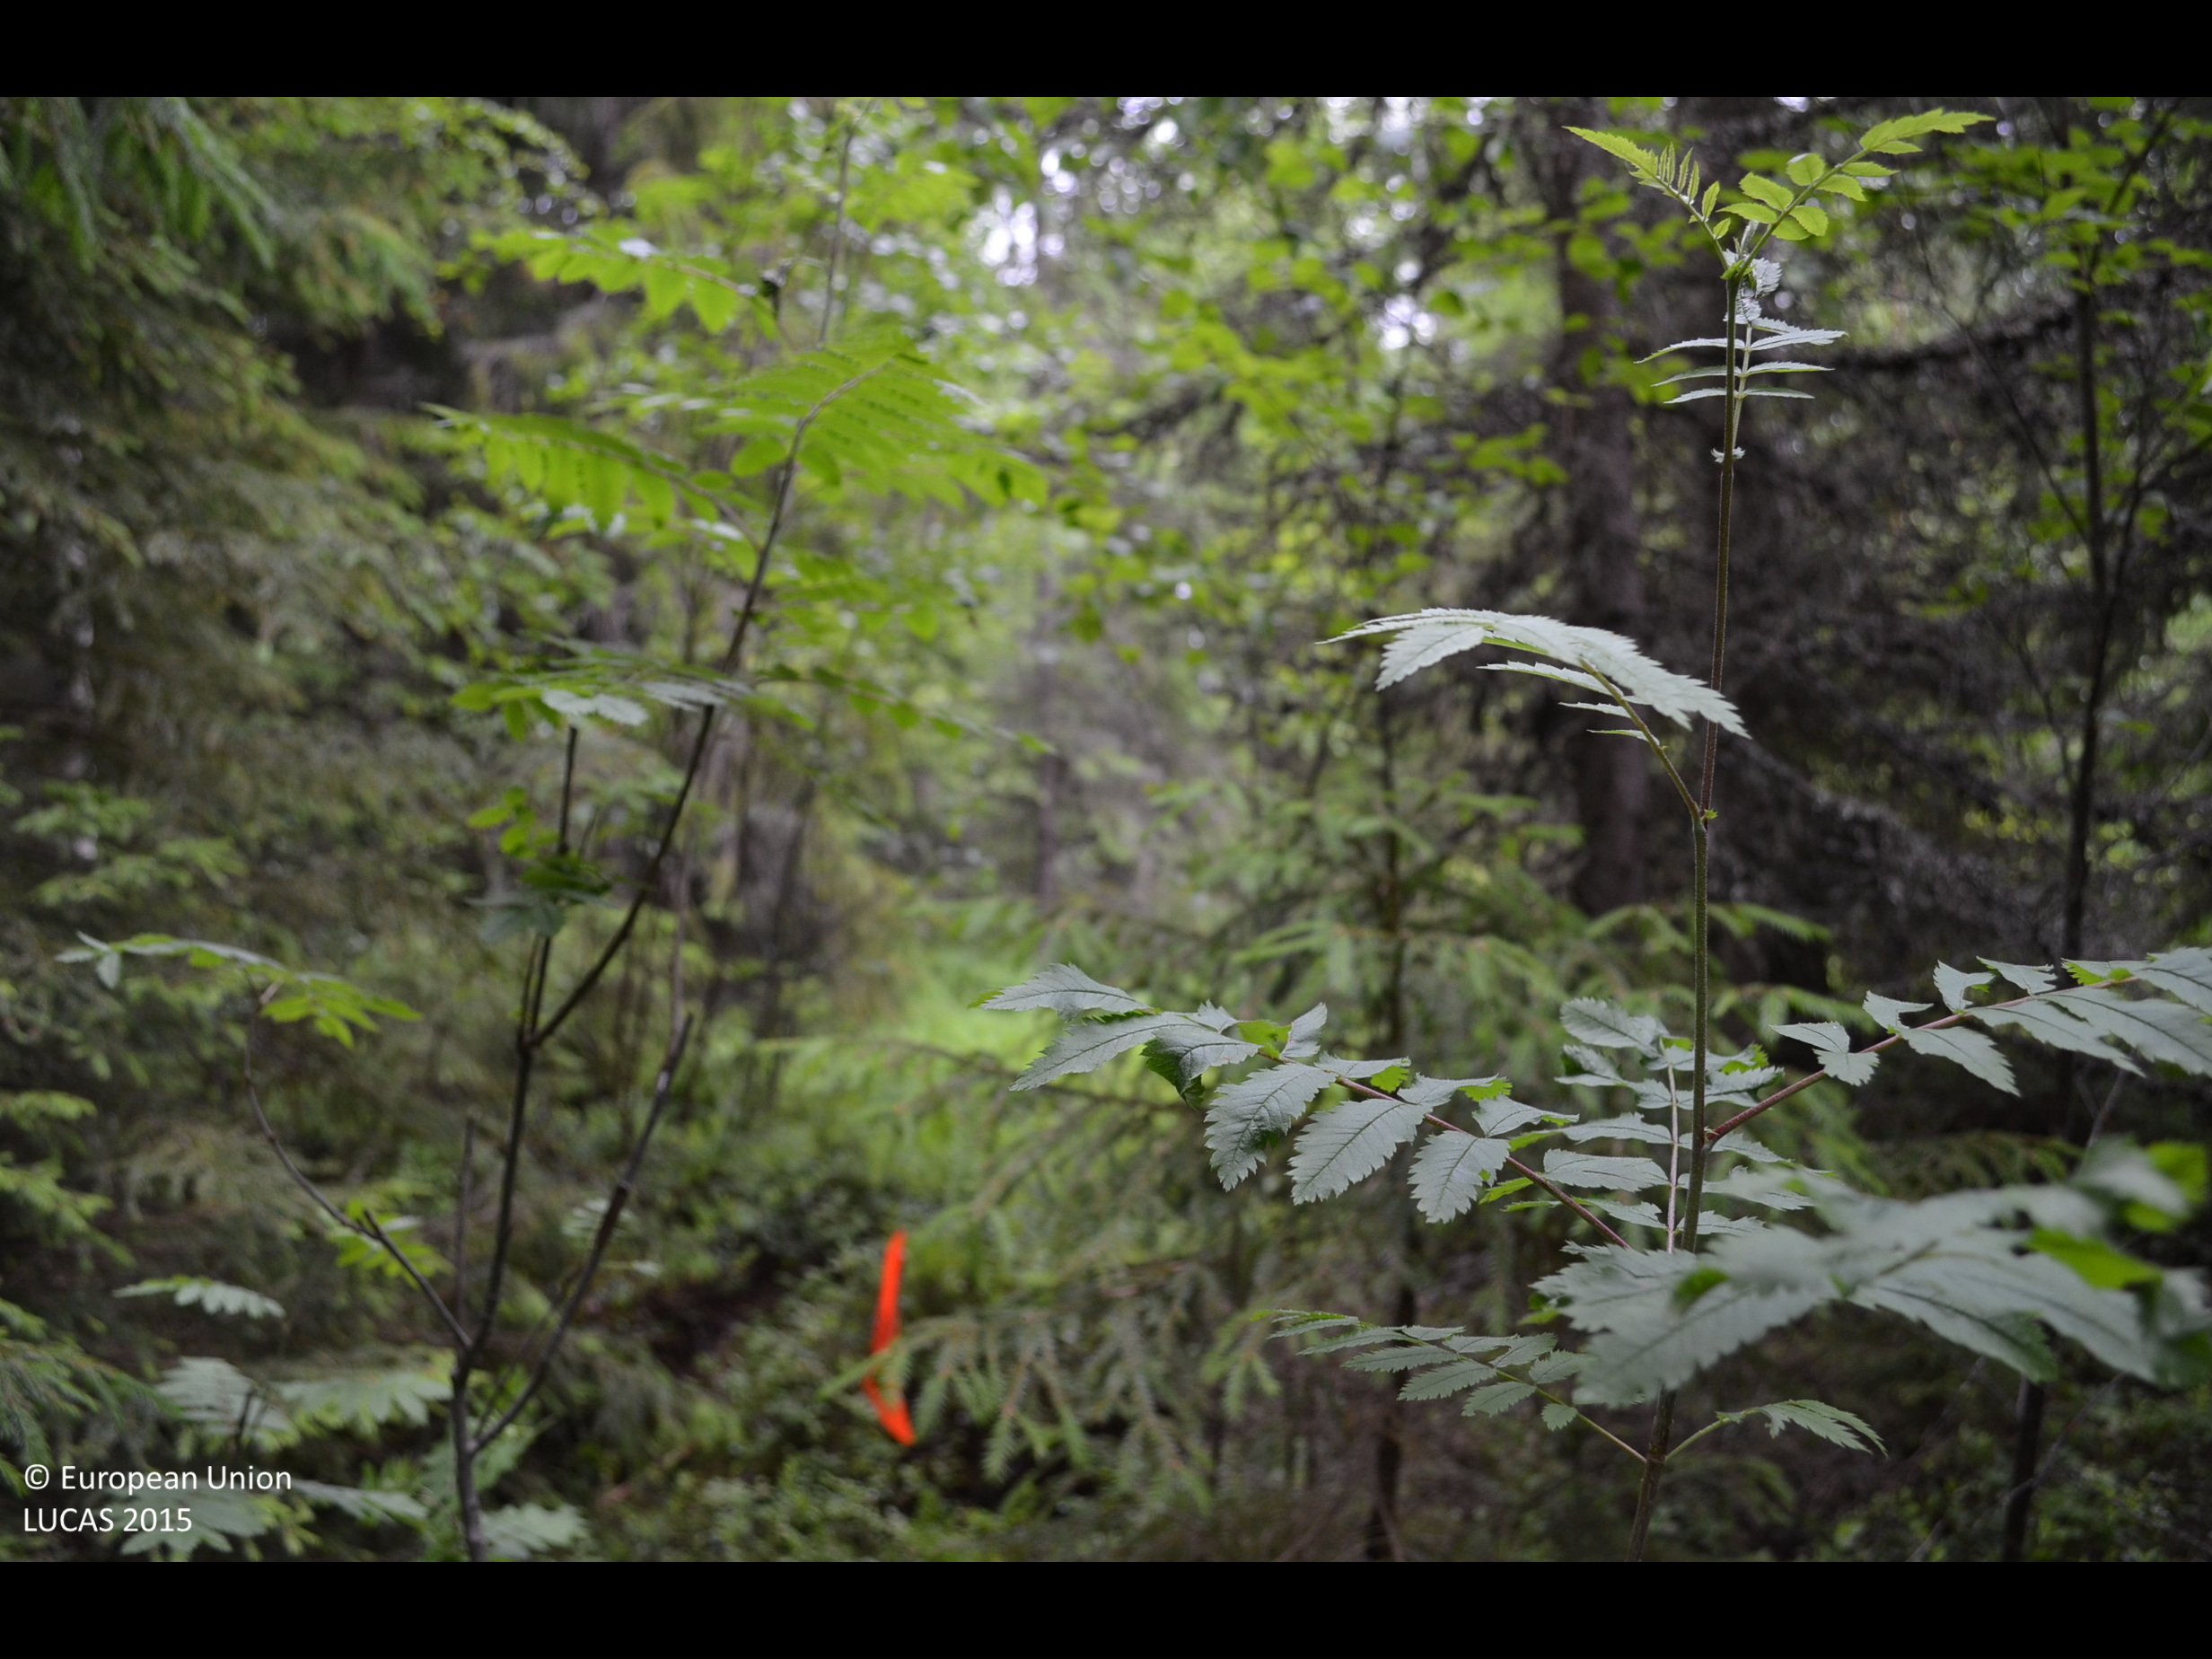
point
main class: Woodland
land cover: Spruce dominated mixed woodland
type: boreal forest
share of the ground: > 75 %
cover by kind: coniferous forest trees 60 %, broadleaved forest trees 30 %, shrubs 10 %
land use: Forestry
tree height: > 5 m
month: June
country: FI
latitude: 61.7045
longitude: 23.3315
